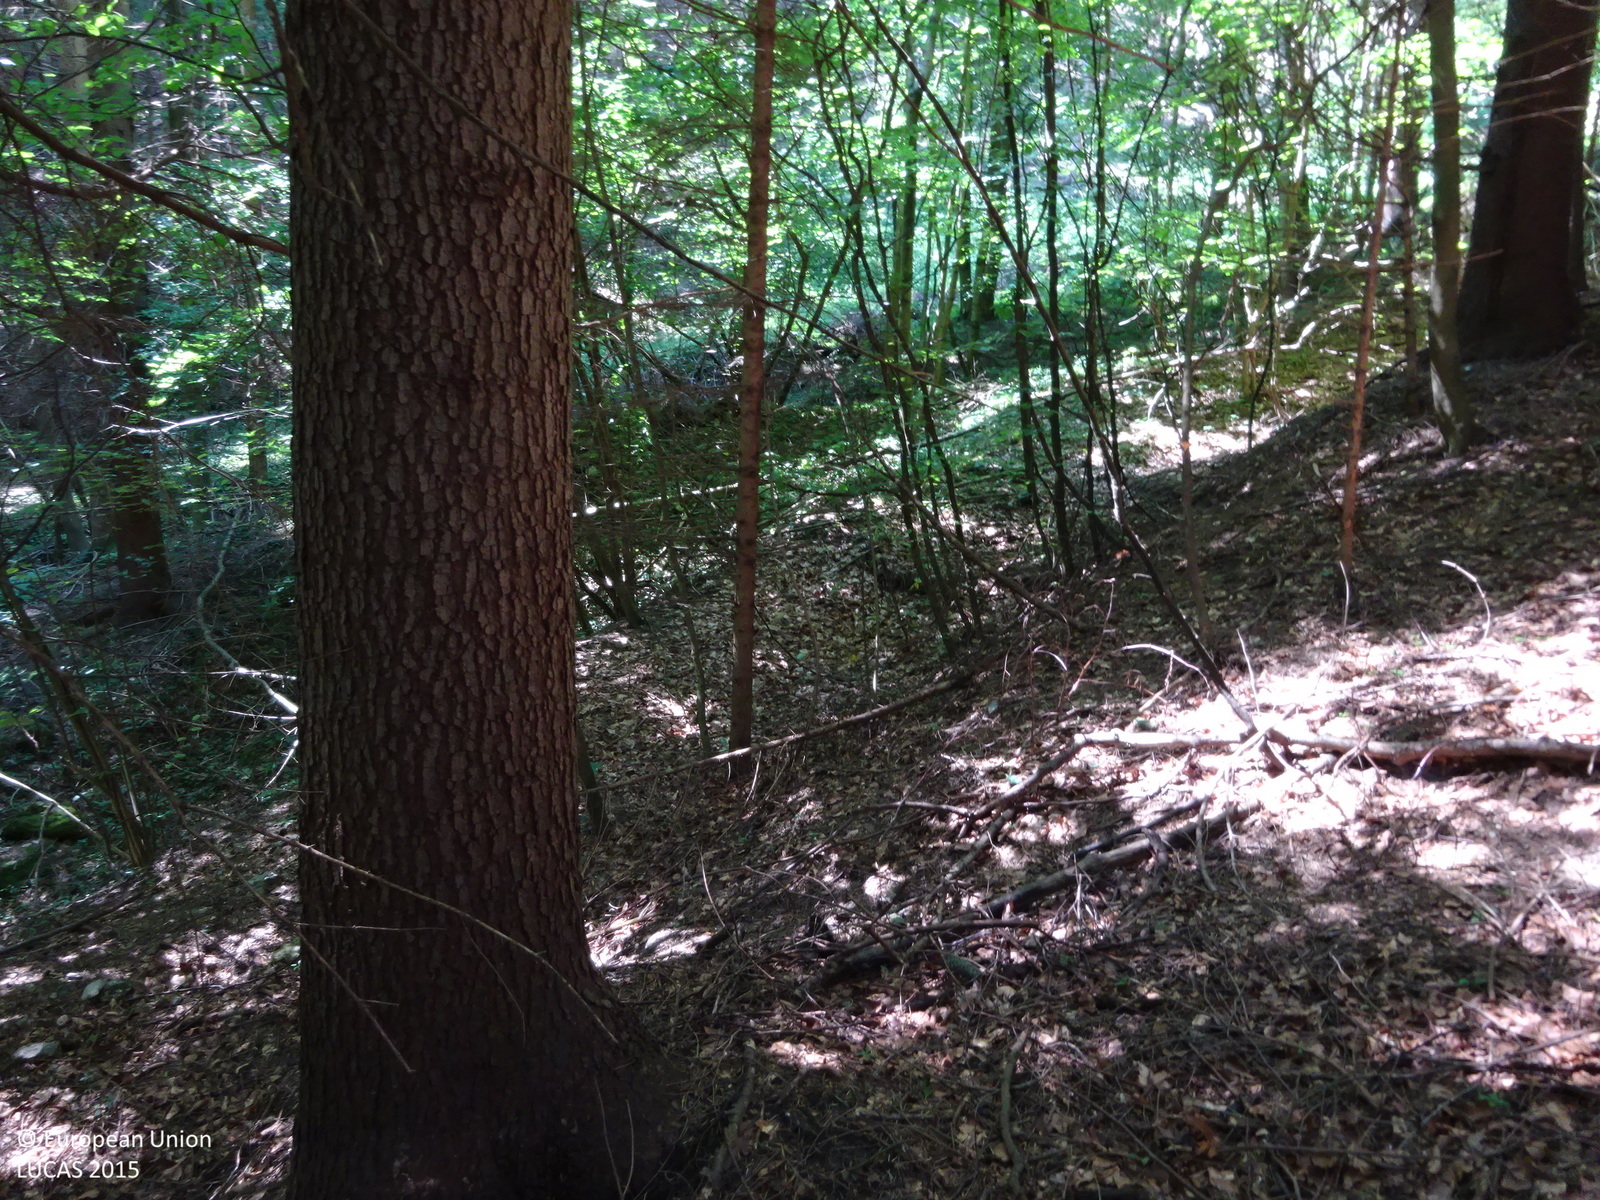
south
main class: Woodland
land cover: Spruce dominated mixed woodland
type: mountainous beech forest
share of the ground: > 75 %
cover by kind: coniferous forest trees 75 %, broadleaved forest trees 25 %
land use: Forestry
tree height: > 5 m
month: July
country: AT
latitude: 47.2664
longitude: 15.3000
